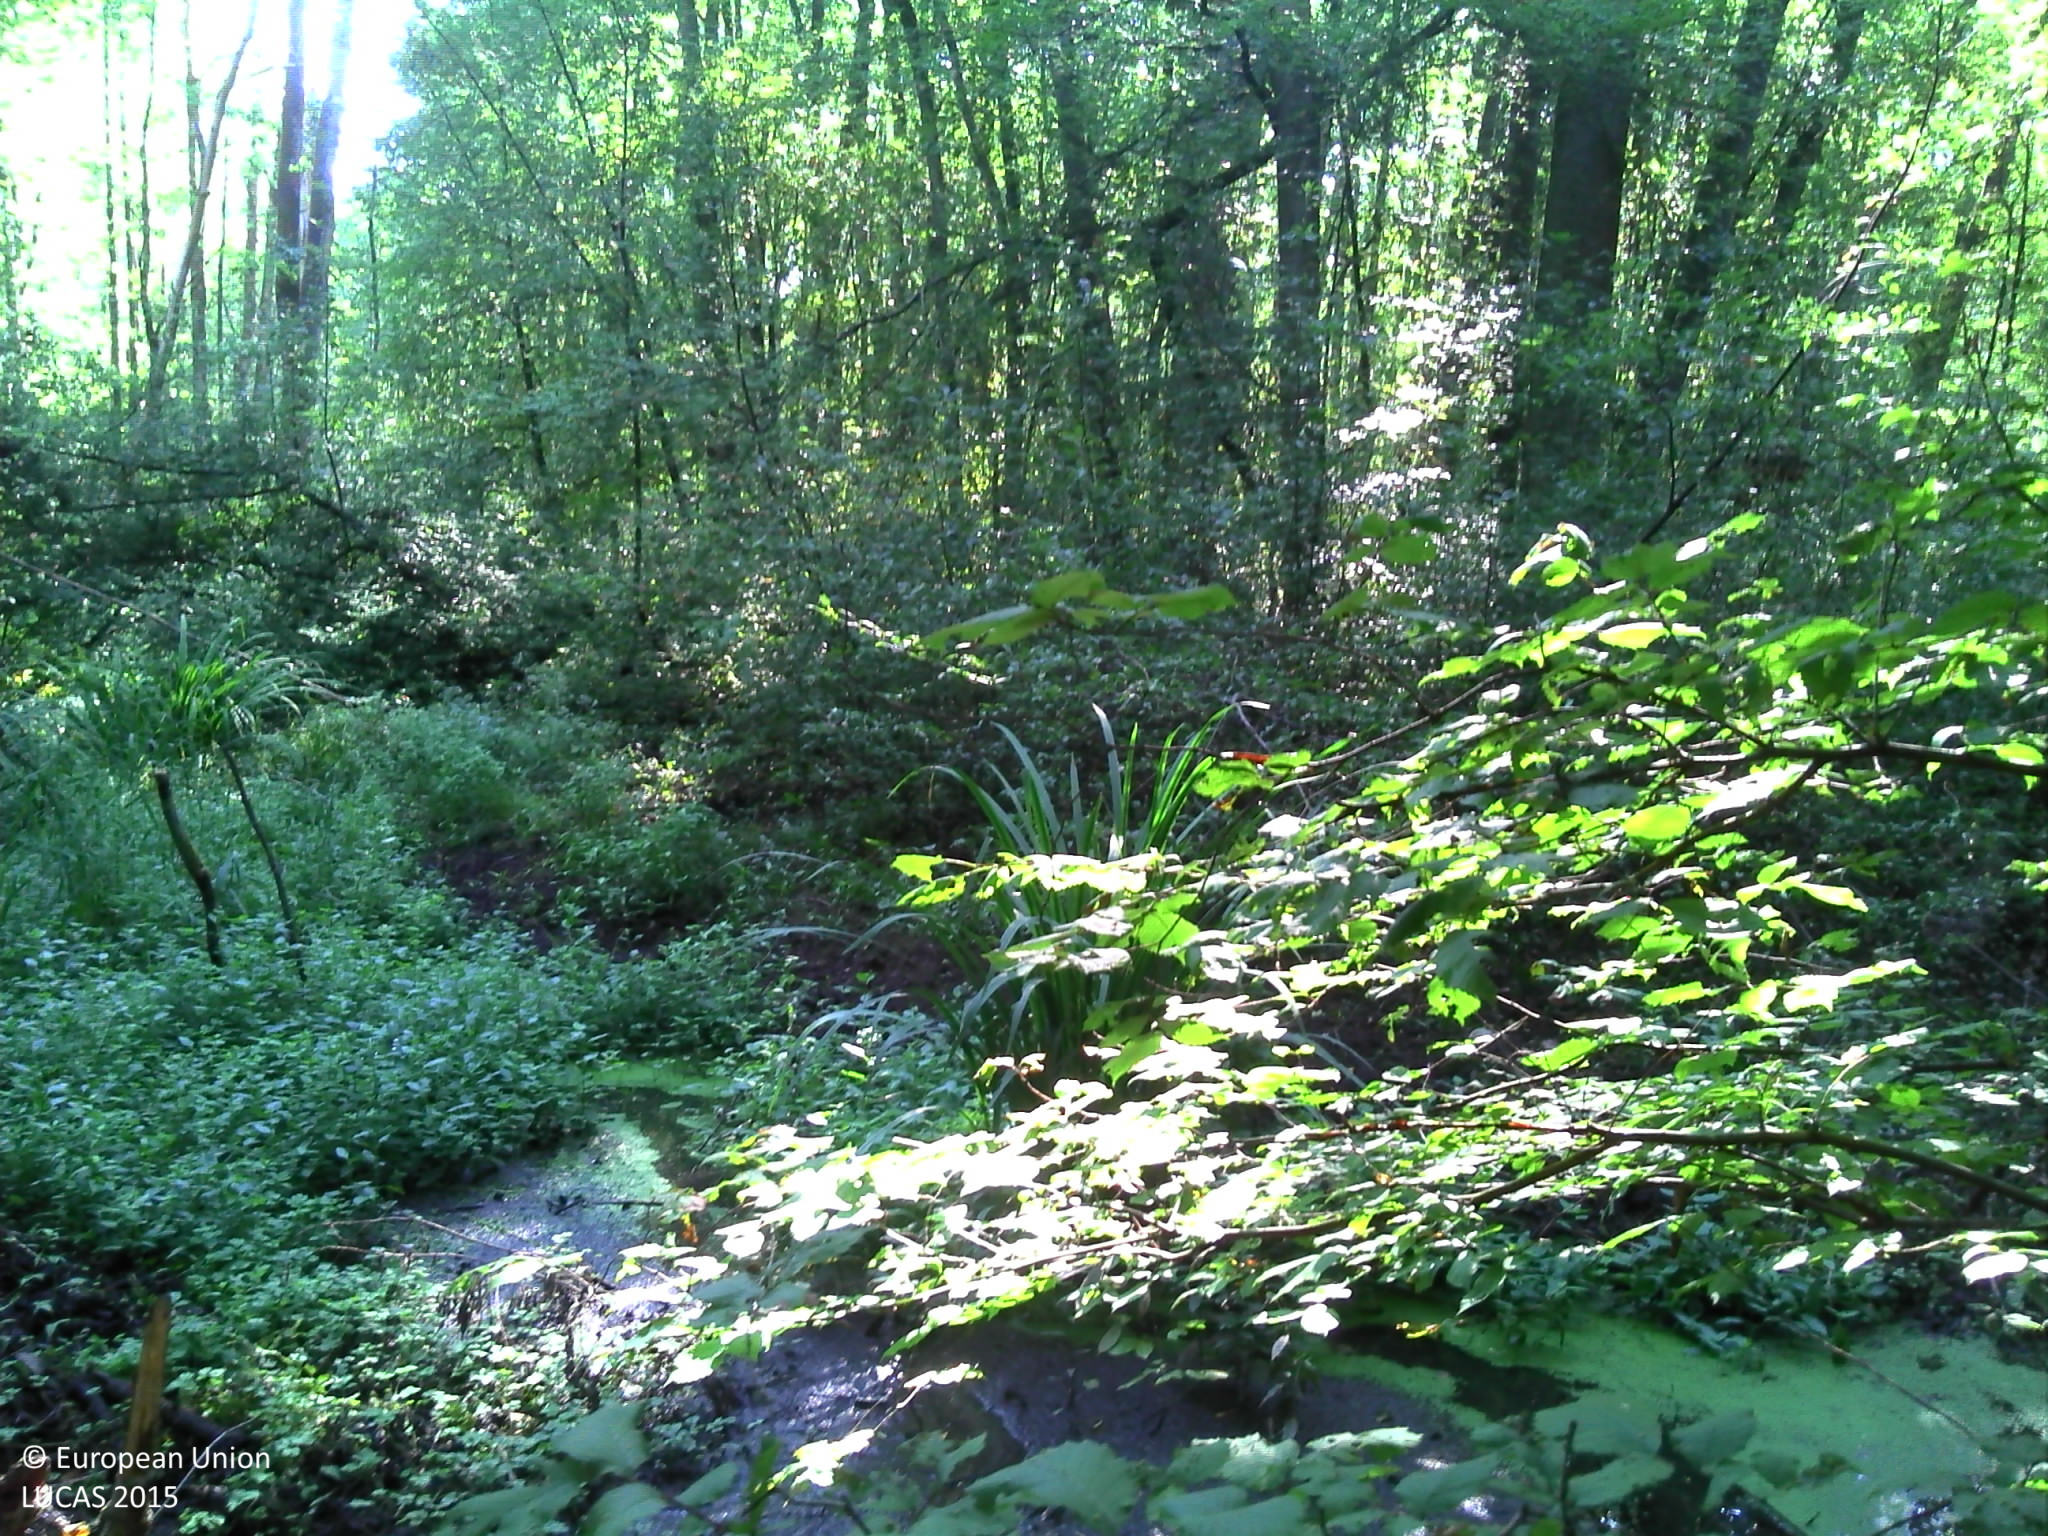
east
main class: Woodland
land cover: Broadleaved woodland
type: beech forest
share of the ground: > 75 %
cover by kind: broadleaved forest trees 95 %, herbaceous plants 5 %
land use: Semi-natural and natural areas not in use
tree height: > 5 m
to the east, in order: Broadleaved woodland; Rivers and streams; Broadleaved woodland
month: August
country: FR
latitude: 48.8533
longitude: 7.9973
